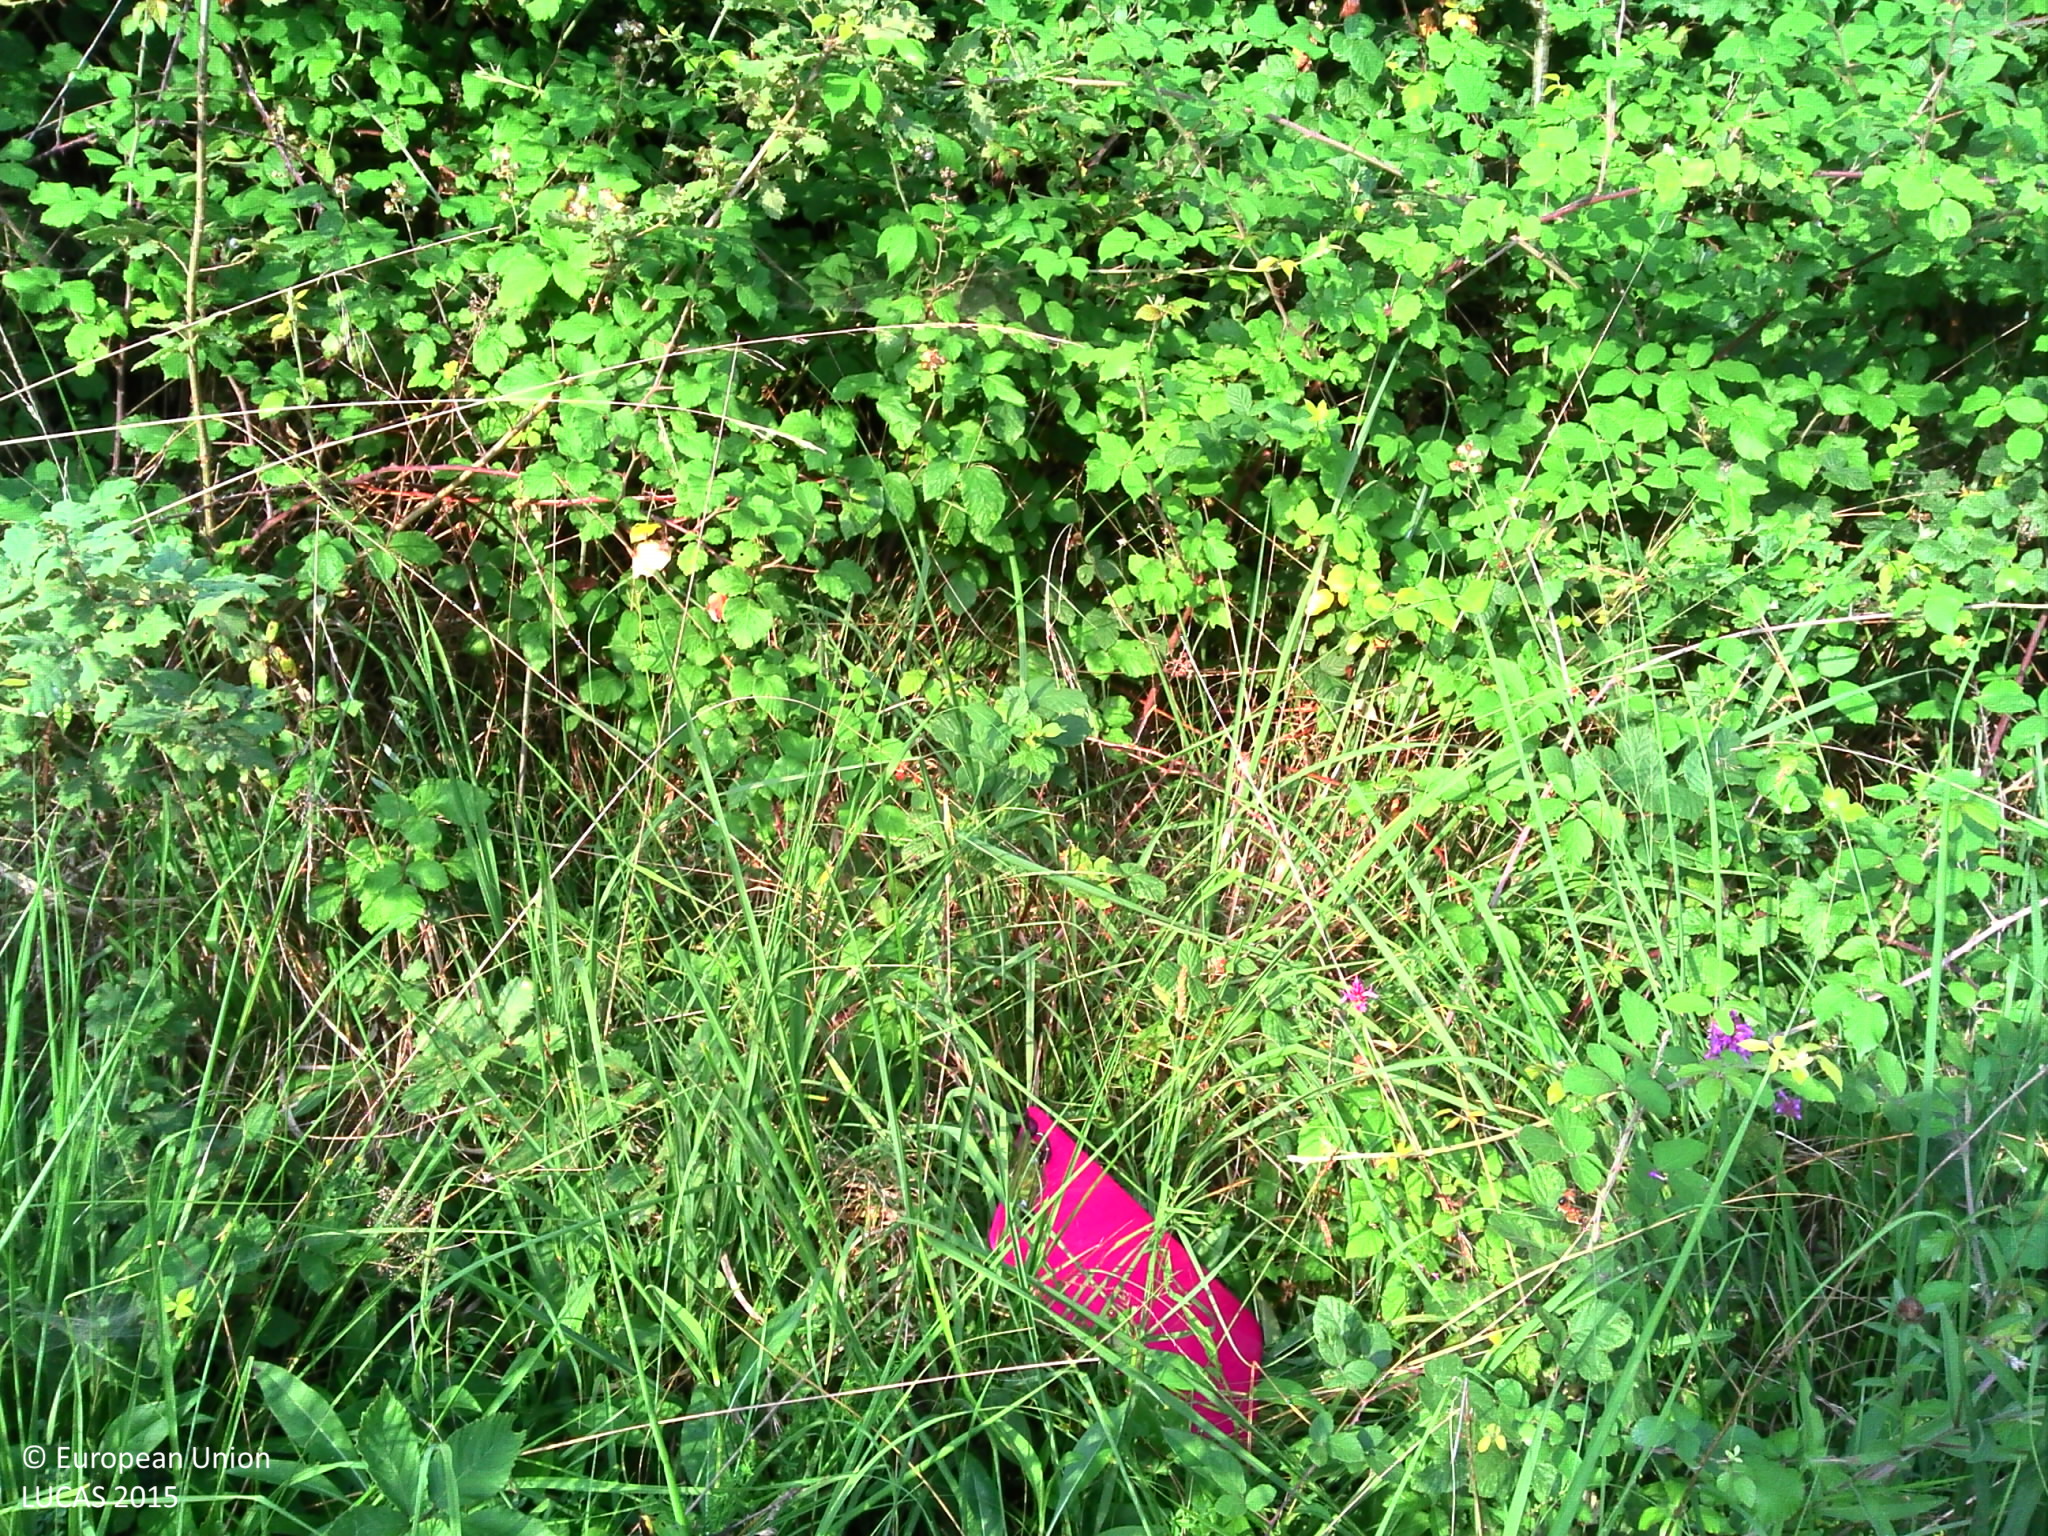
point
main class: Grassland
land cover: Spontaneously vegetated surfaces
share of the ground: > 75 %
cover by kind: herbaceous plants 100 %
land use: Semi-natural and natural areas not in use
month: July
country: FR
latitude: 43.1343
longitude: 1.1155
